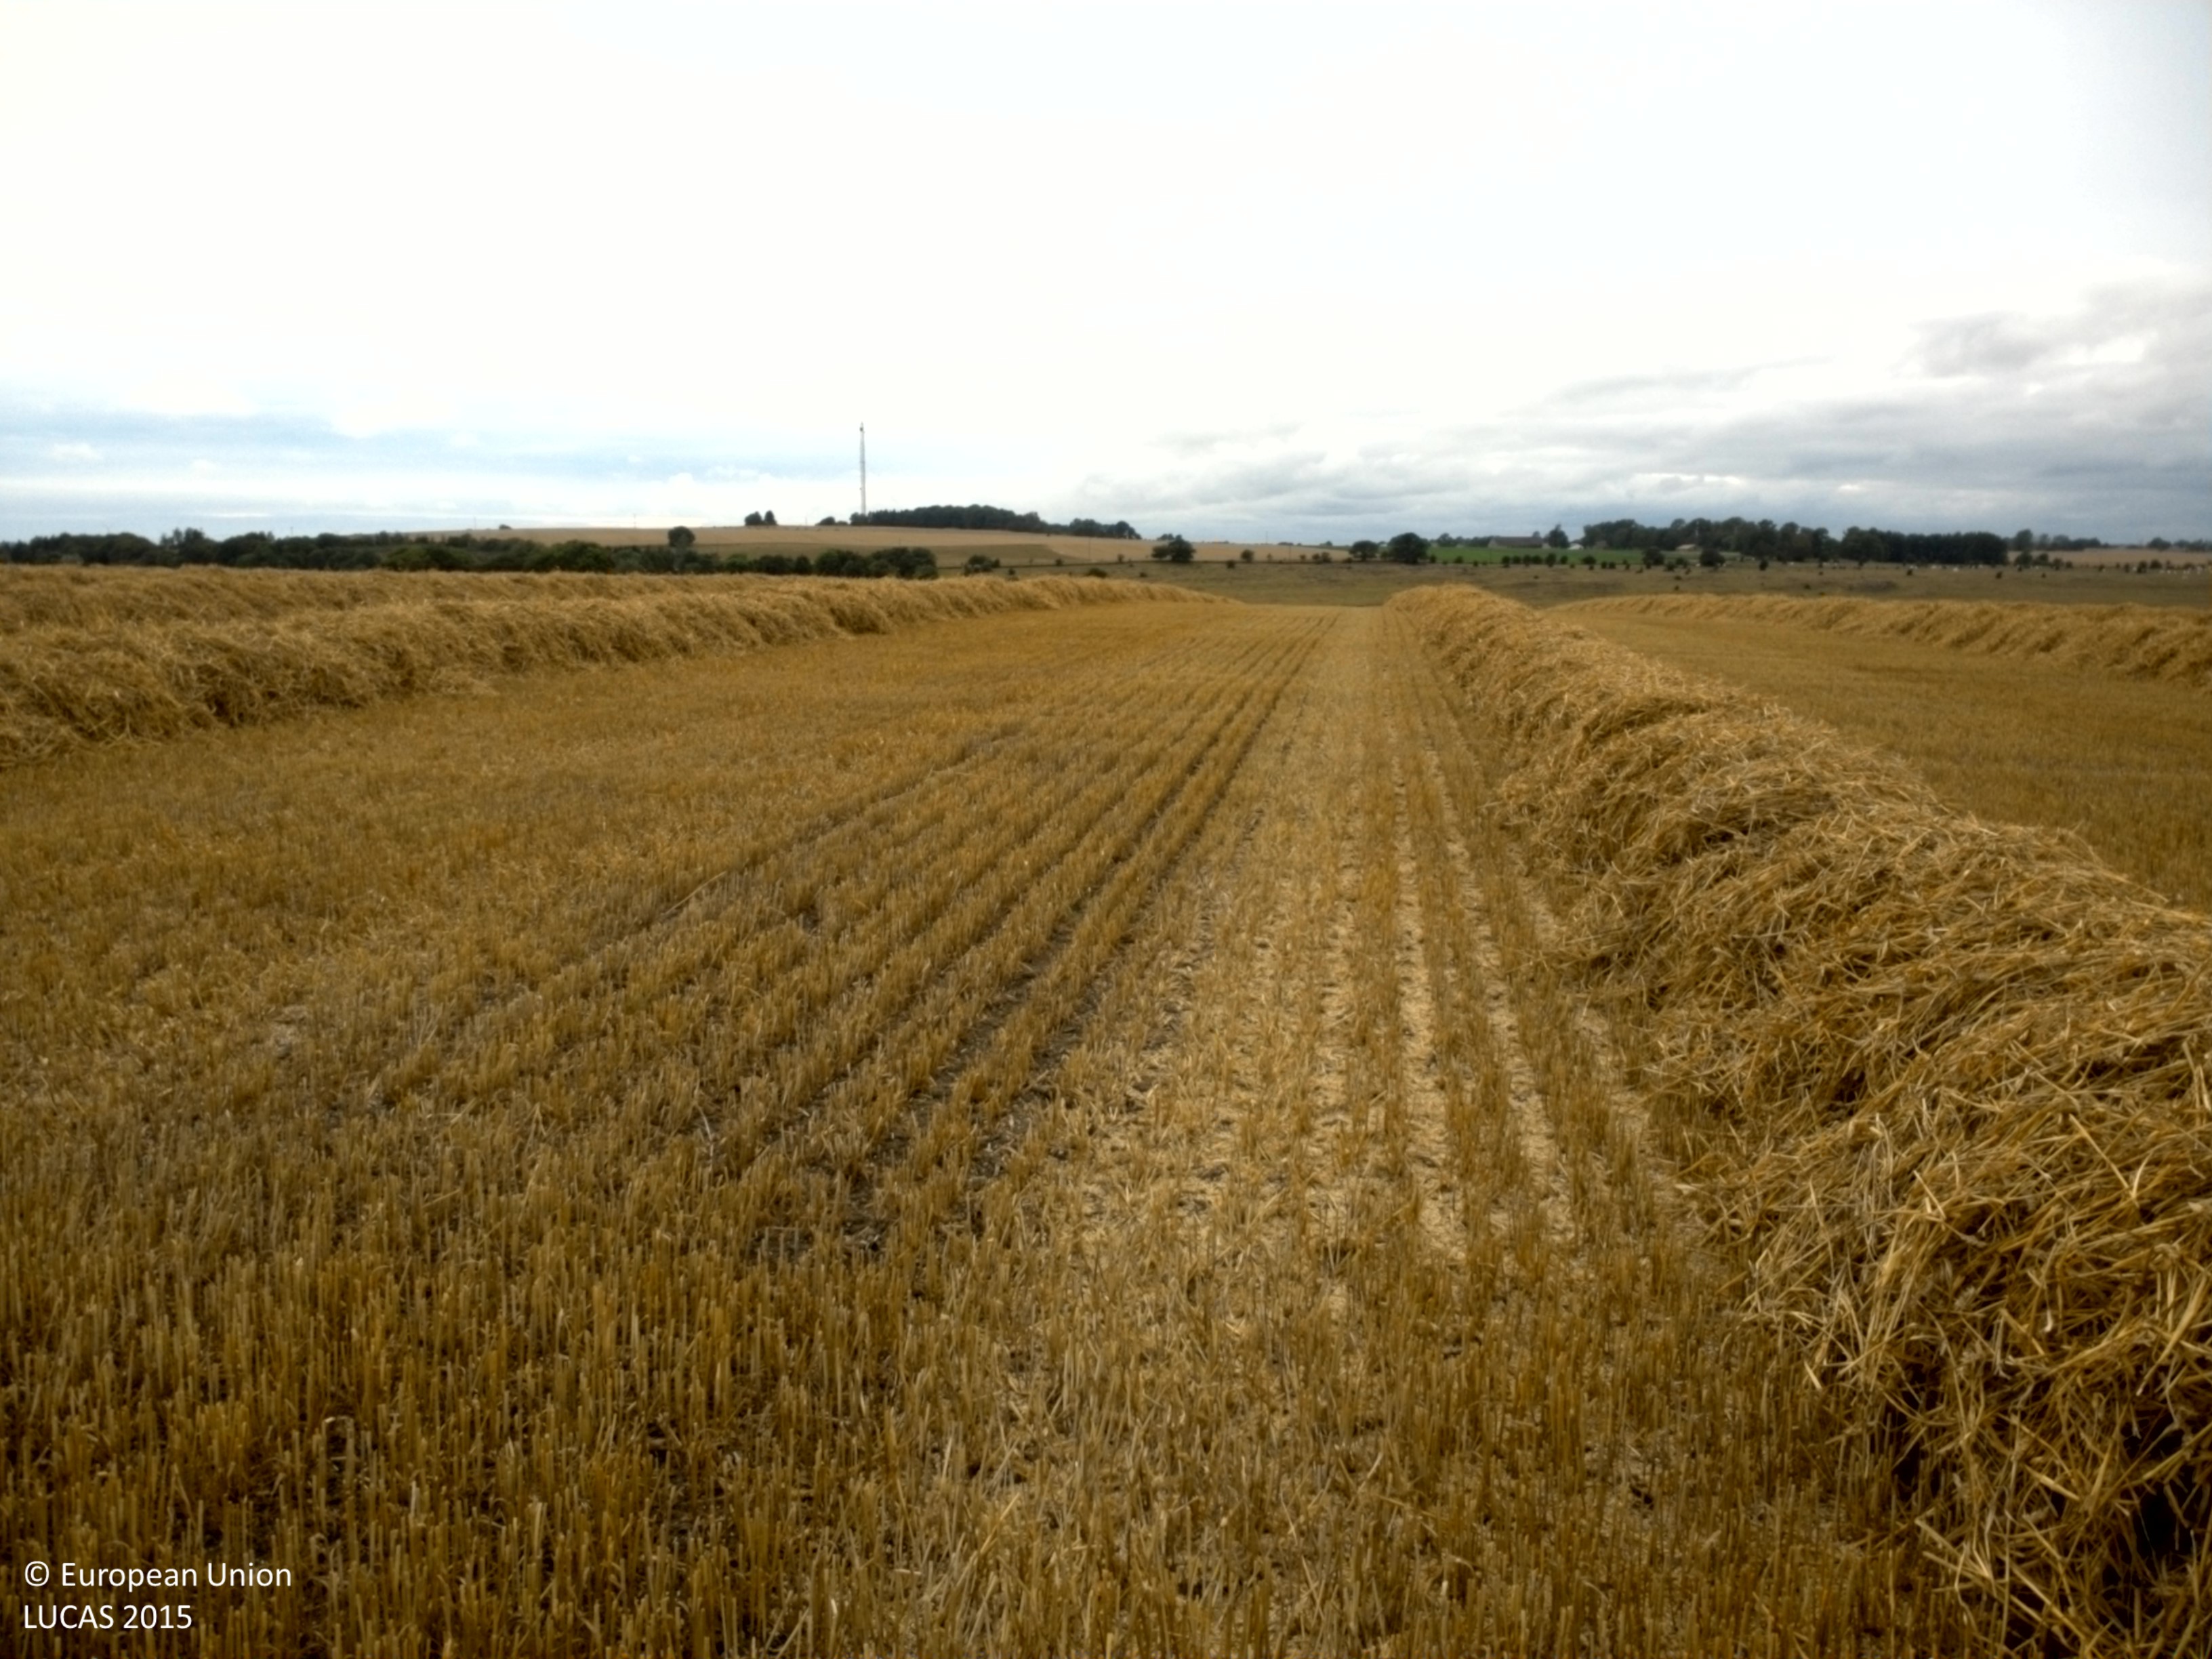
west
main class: Cropland
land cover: Common wheat
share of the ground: 25 - 50 %
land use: Agriculture (excluding fallow land and kitchen gardens)
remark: Harvested field
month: September
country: SE
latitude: 55.5040
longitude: 14.2894
